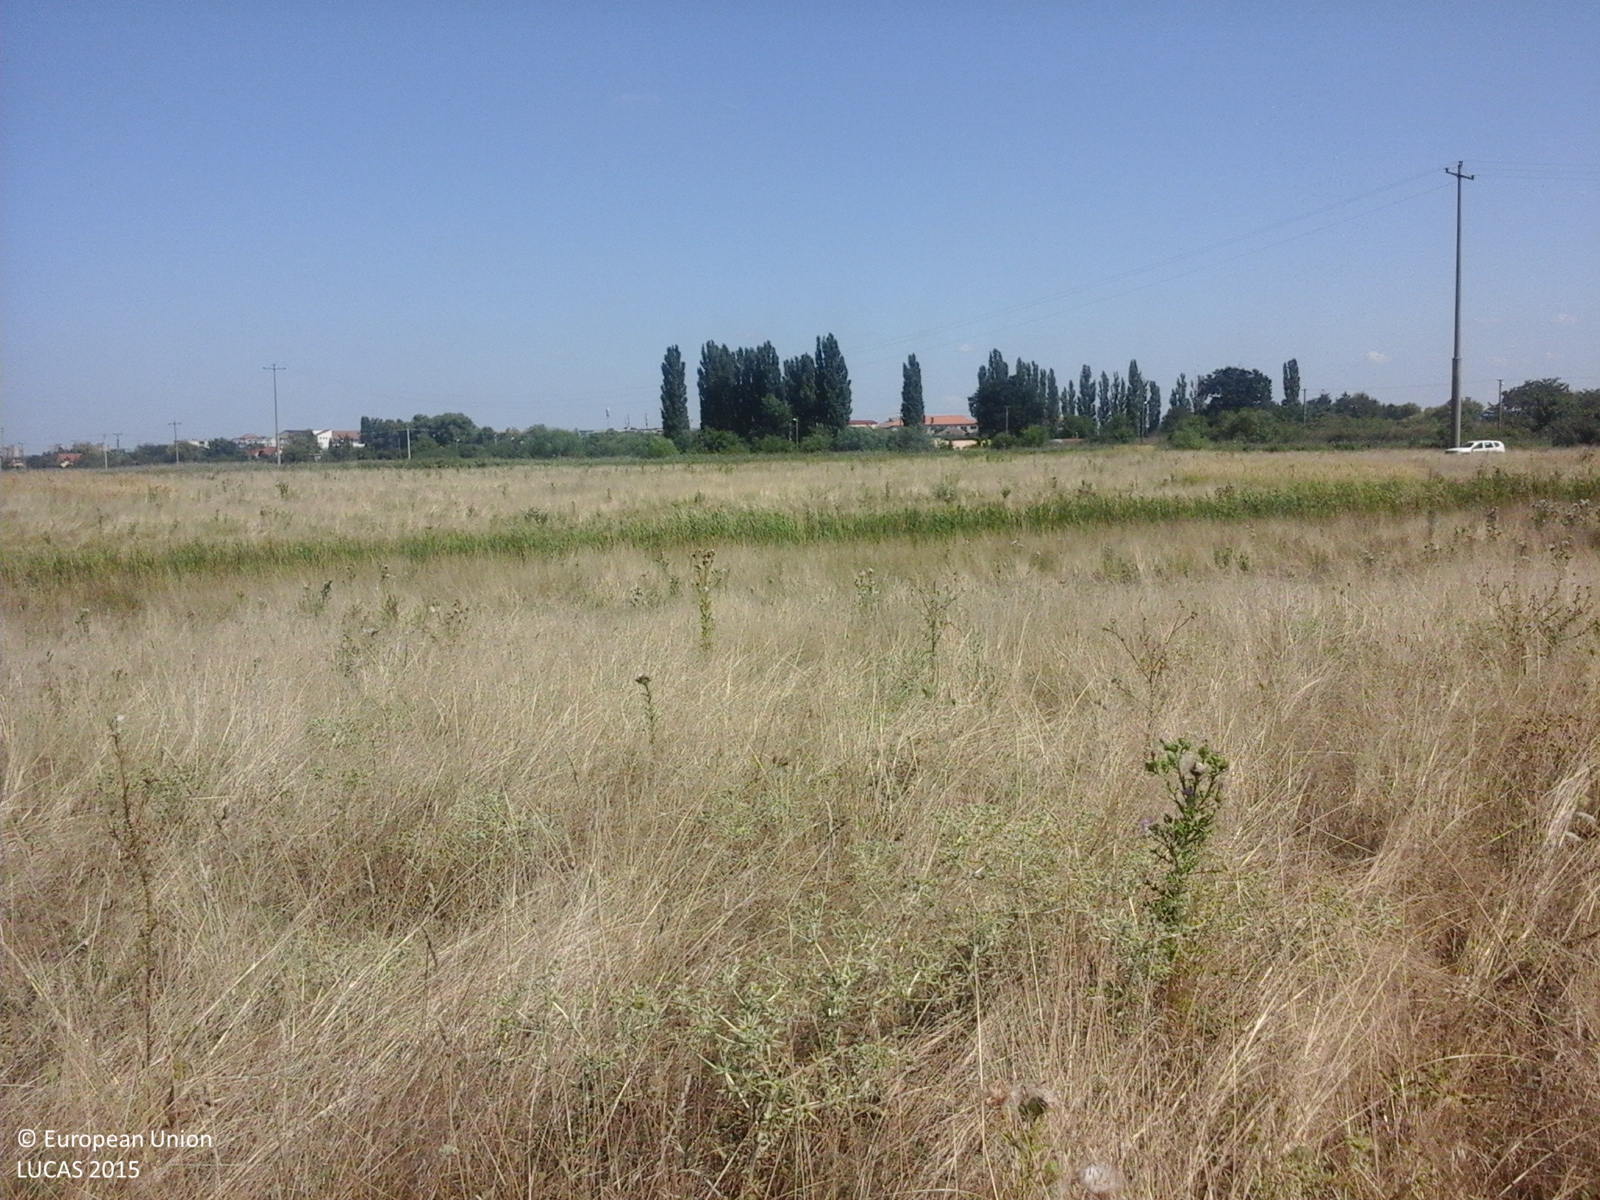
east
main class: Grassland
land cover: Spontaneously vegetated surfaces
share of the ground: > 75 %
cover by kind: herbaceous plants 100 %
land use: Fallow land
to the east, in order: Spontaneously vegetated surfaces; Ditches and canals; Spontaneously vegetated surfaces; Tracks; Spontaneously vegetated surfaces; Electric lines; Spontaneously vegetated surfaces; Inland marshes; Inland fresh water bodies; Inland marshes
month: August
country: RO
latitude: 45.7278
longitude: 21.1703
